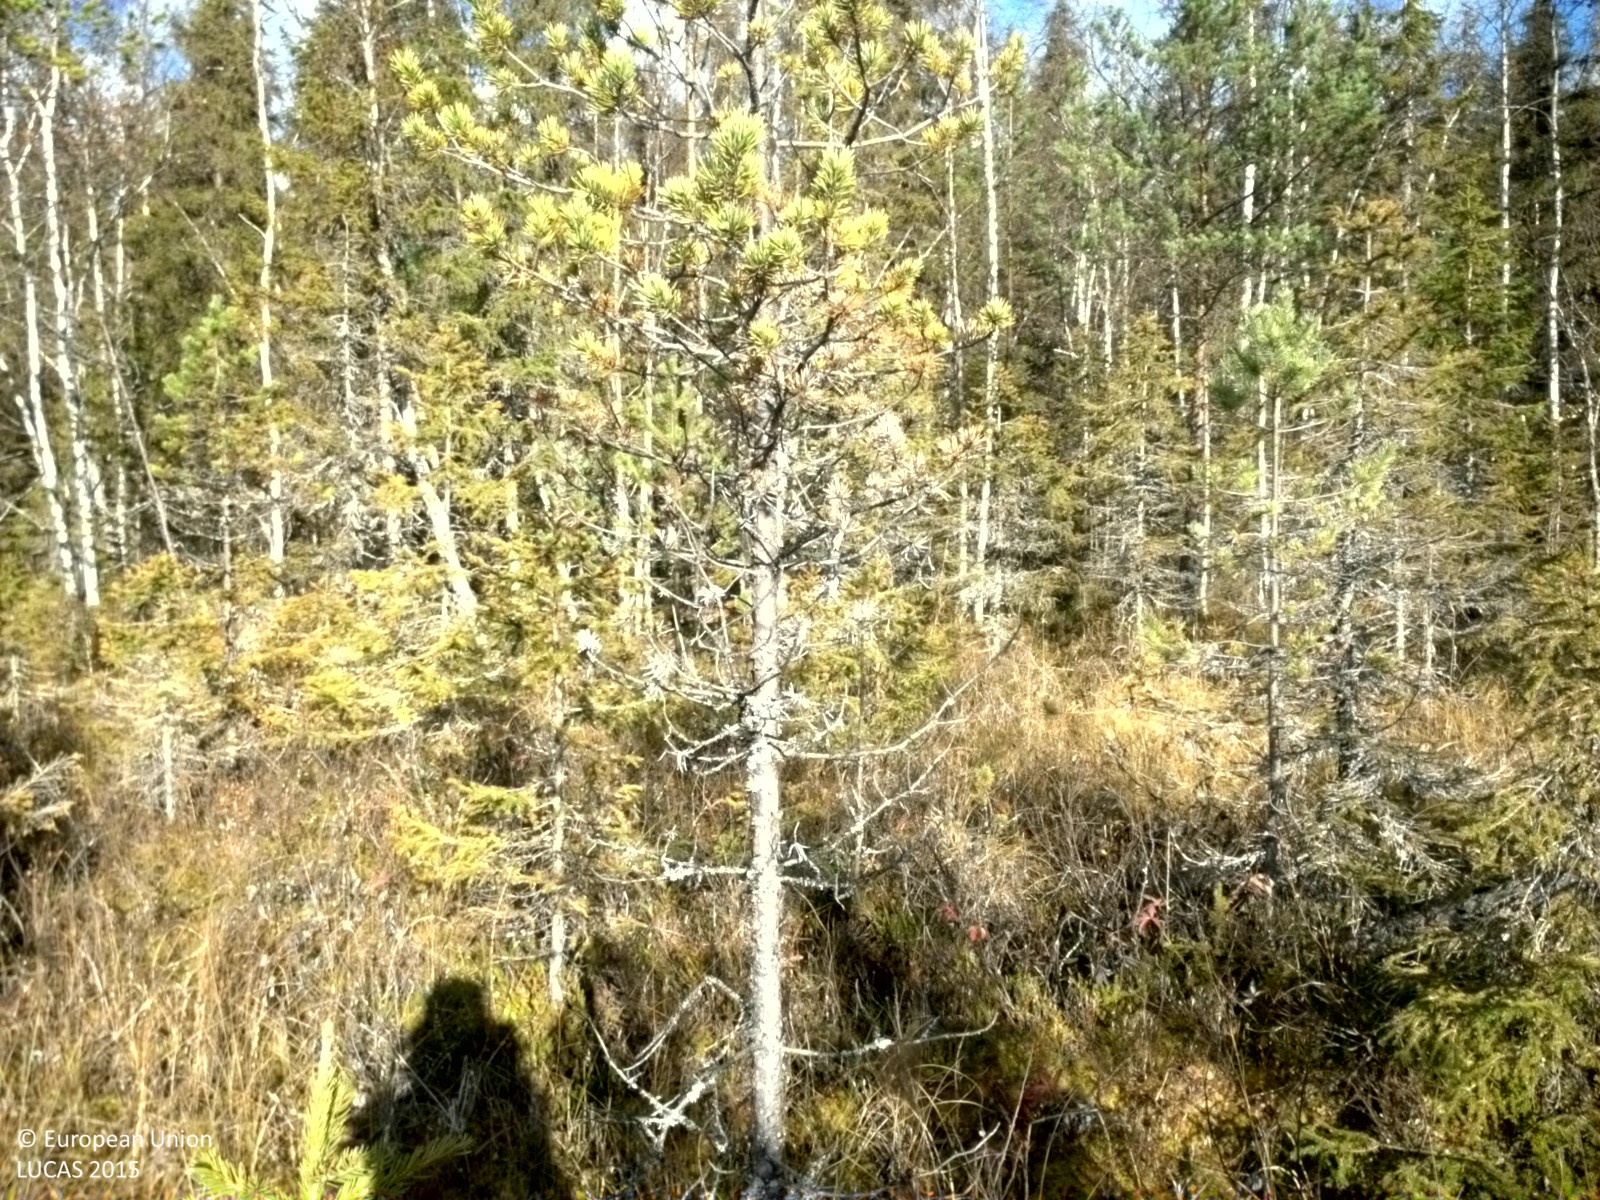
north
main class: Woodland
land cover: Pine dominated coniferous woodland
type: mire and swamp forests
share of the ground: 10 - 25 %
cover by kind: herbaceous plants 75 %, coniferous forest trees 15 %, shrubs 10 %
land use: Forestry
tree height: > 5 m
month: October
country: SE
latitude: 65.7768
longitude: 21.4381
